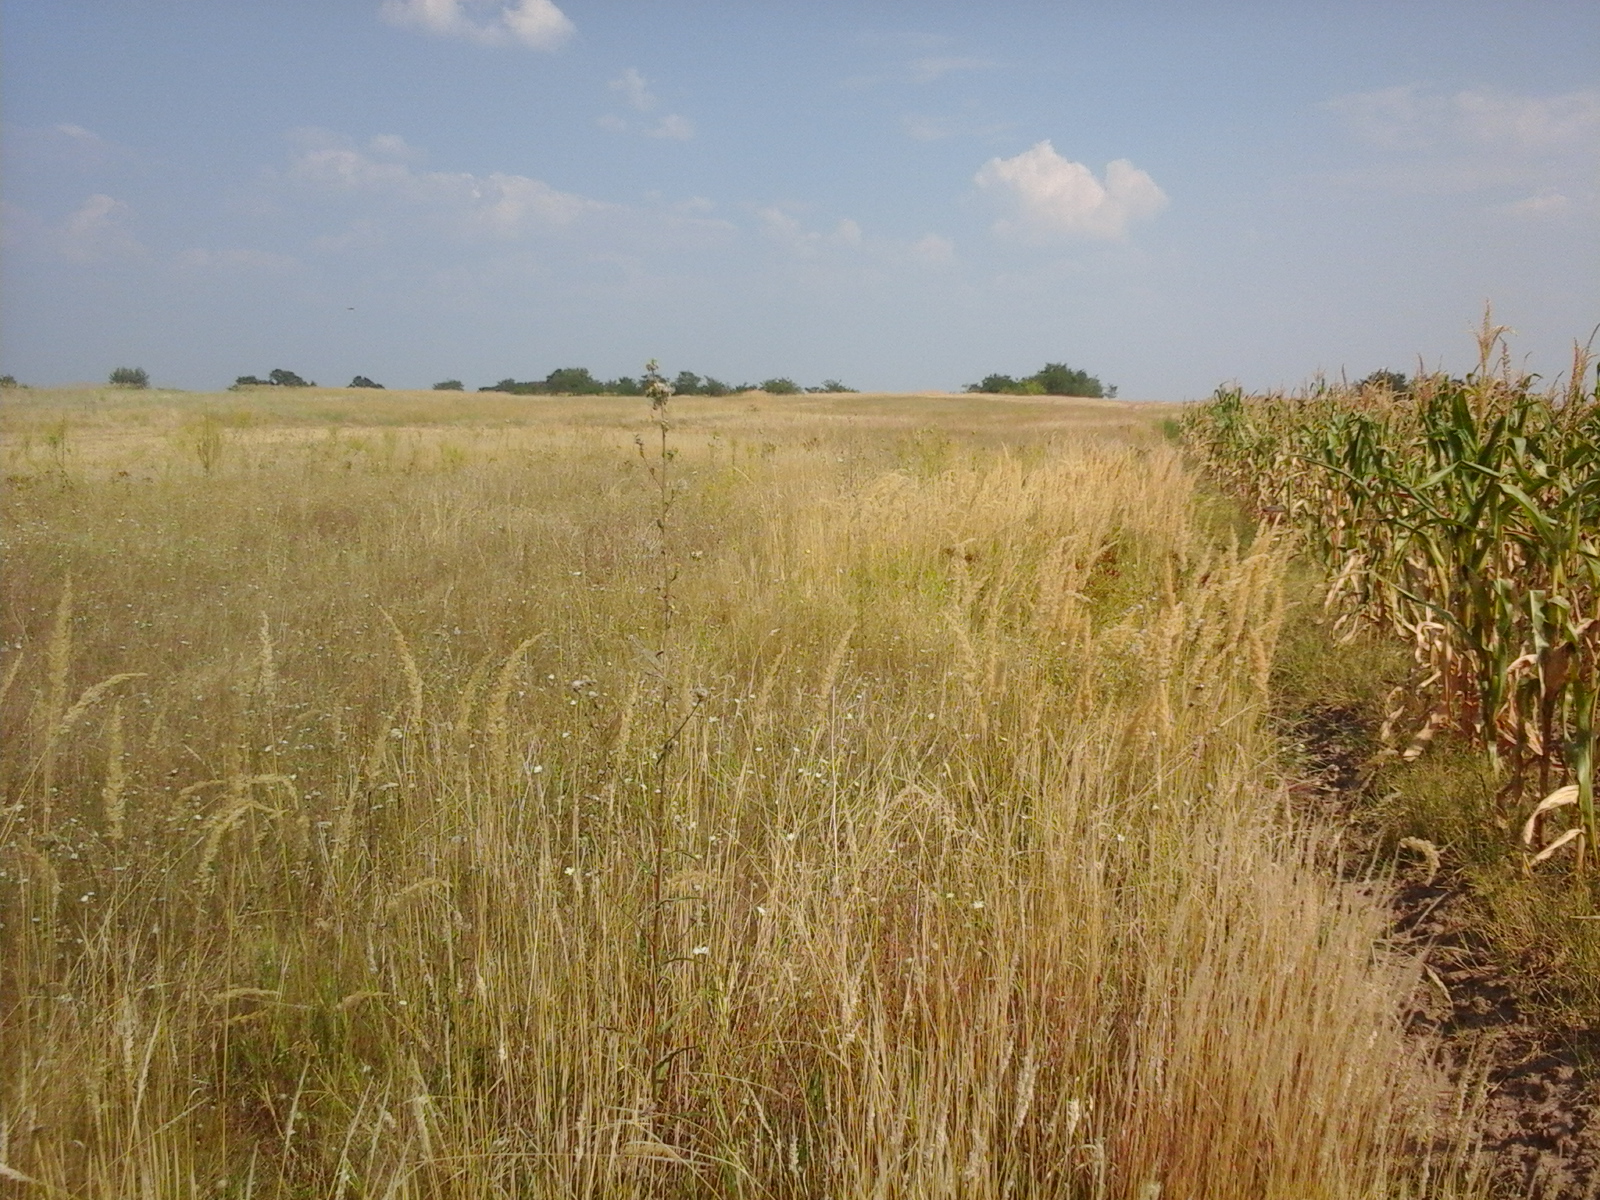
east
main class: Cropland
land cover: Maize
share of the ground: > 75 %
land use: Agriculture (excluding fallow land and kitchen gardens)
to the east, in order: Maize; Spontaneously vegetated surfaces; Tracks; Spontaneously vegetated surfaces
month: August
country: RO
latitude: 44.4672
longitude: 22.4948
